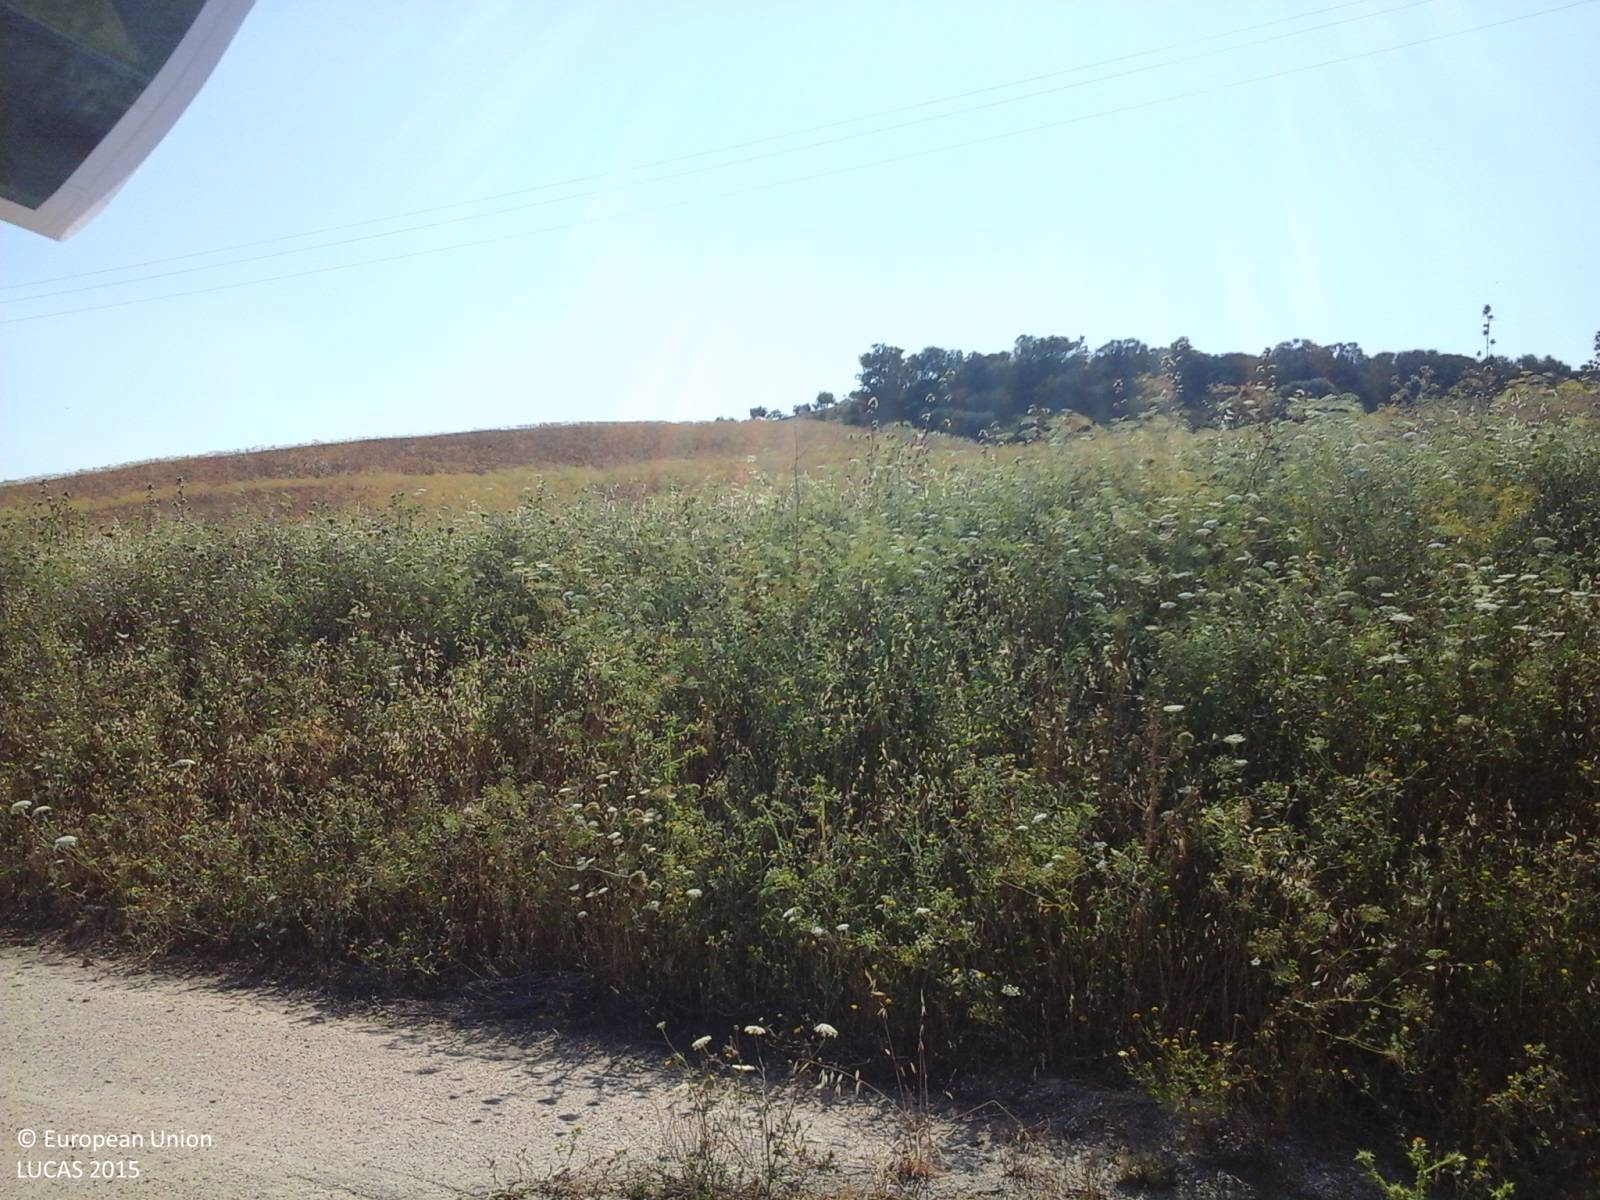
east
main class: Grassland
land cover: Spontaneously vegetated surfaces
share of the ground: > 75 %
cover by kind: herbaceous plants 95 %, shrubs 5 %
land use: Semi-natural and natural areas not in use
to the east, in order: Spontaneously vegetated surfaces; Tracks; Grassland without tree/shrub cover; Dry pulses; Electric lines; Dry pulses; Fences; Olive groves; Broadleaved woodland; Olive groves
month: July
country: IT
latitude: 37.8437
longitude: 13.0572
